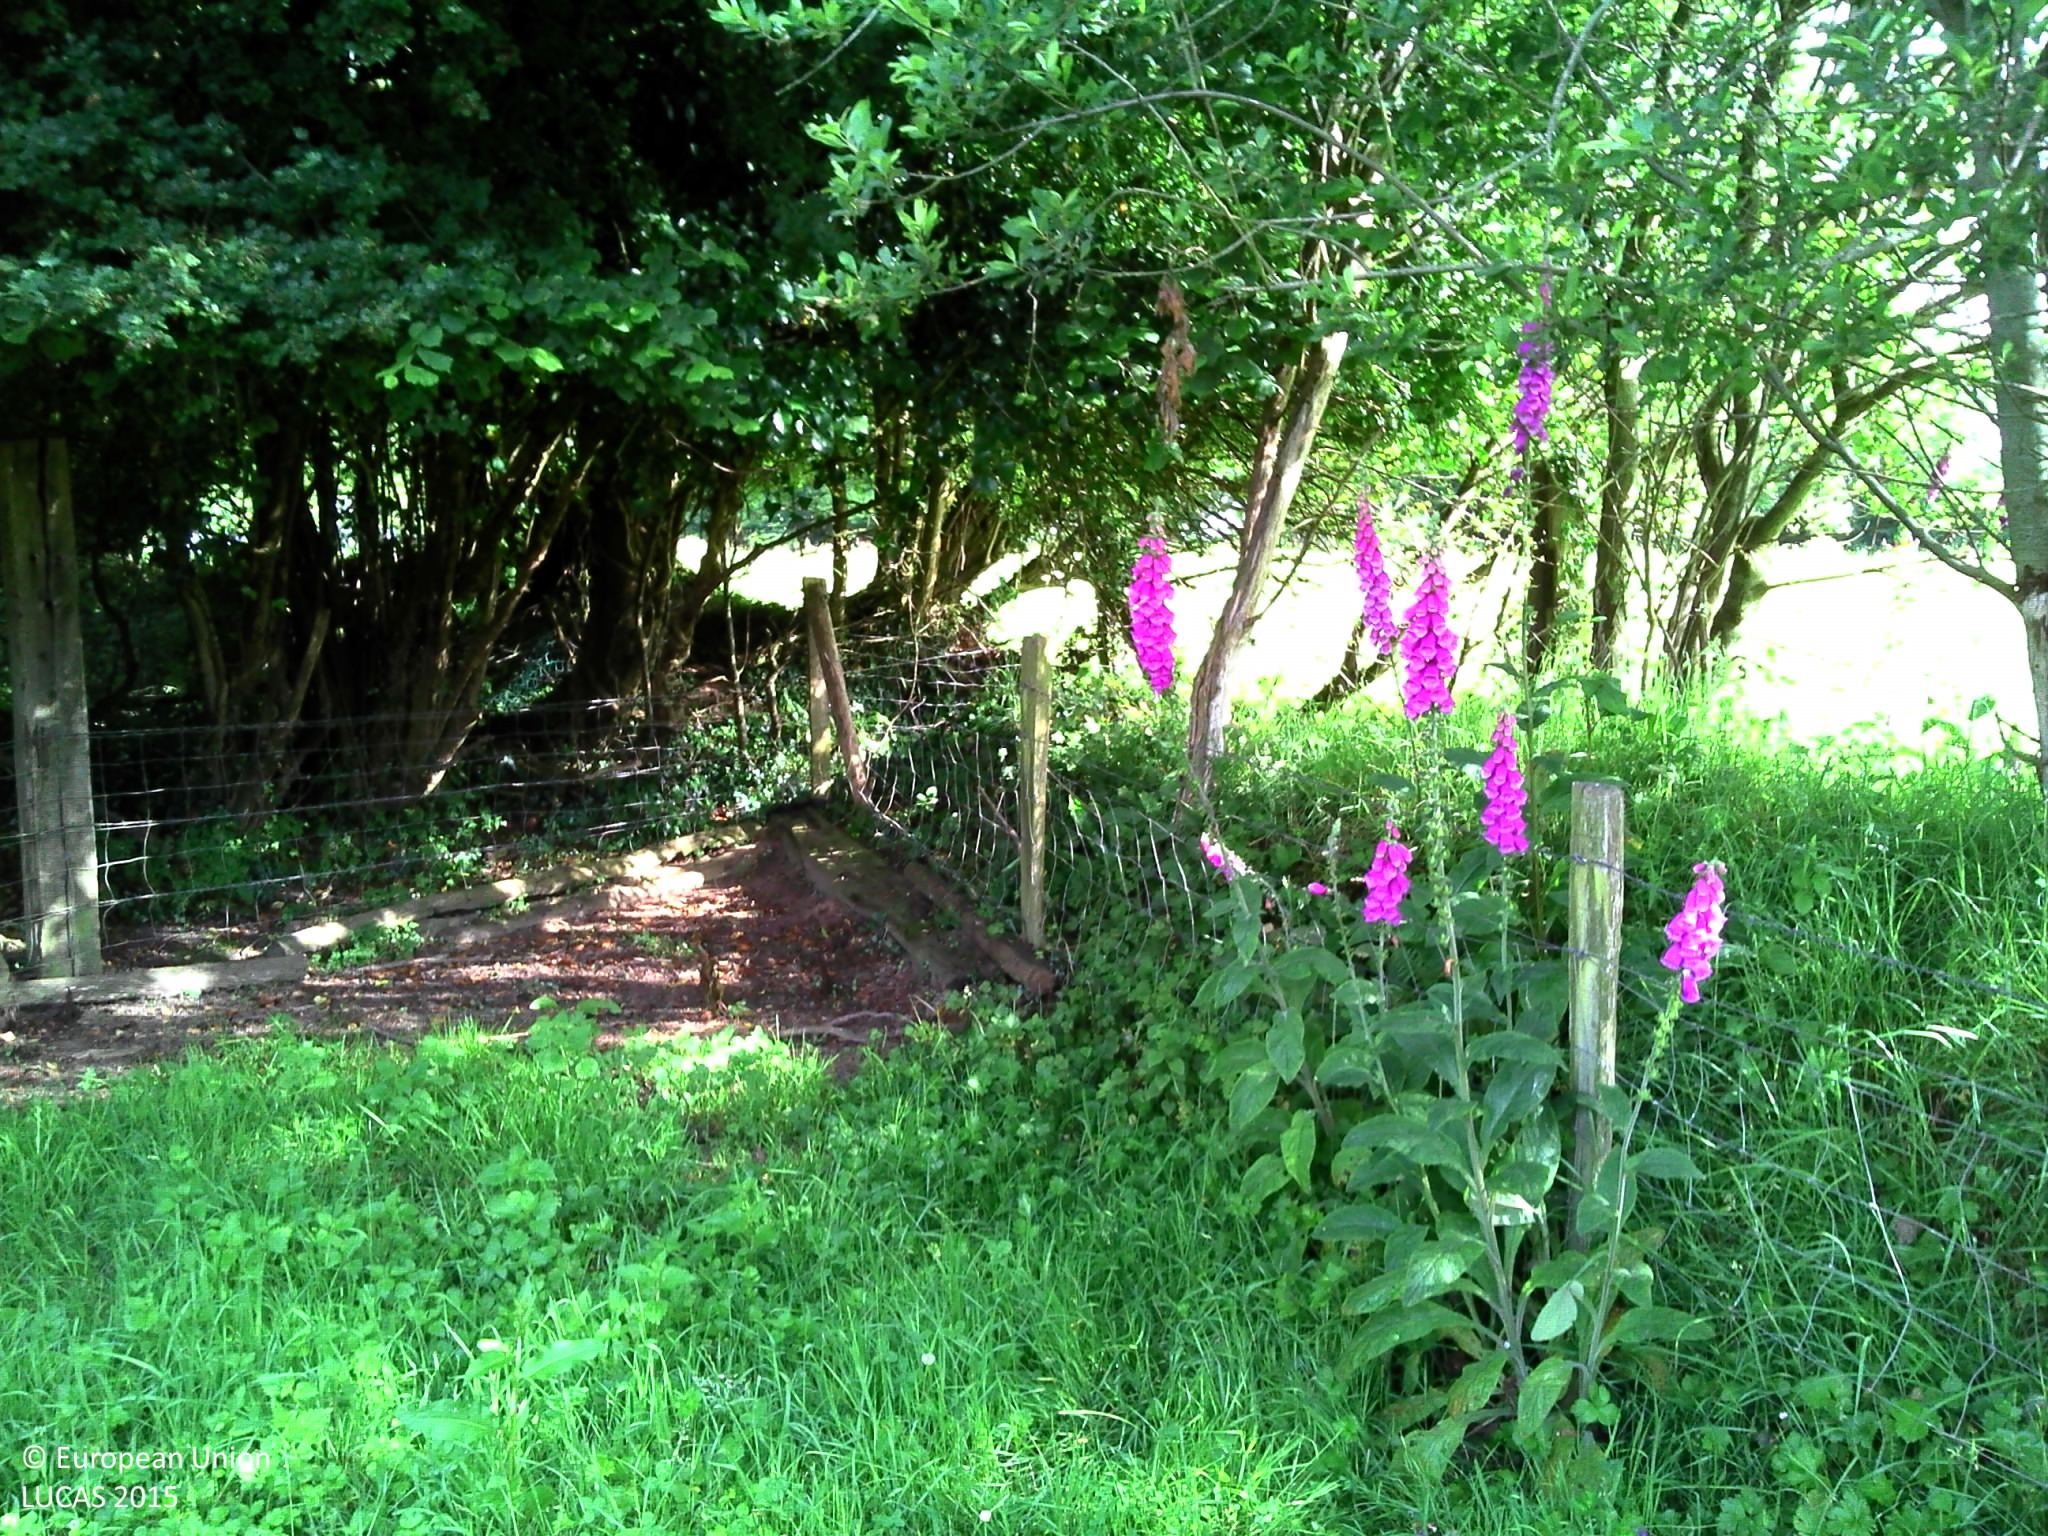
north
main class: Grassland
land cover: Grassland without tree/shrub cover
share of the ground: > 75 %
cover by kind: herbaceous plants 100 %
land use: Agriculture (excluding fallow land and kitchen gardens)
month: June
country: FR
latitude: 49.0782
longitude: -1.4520
